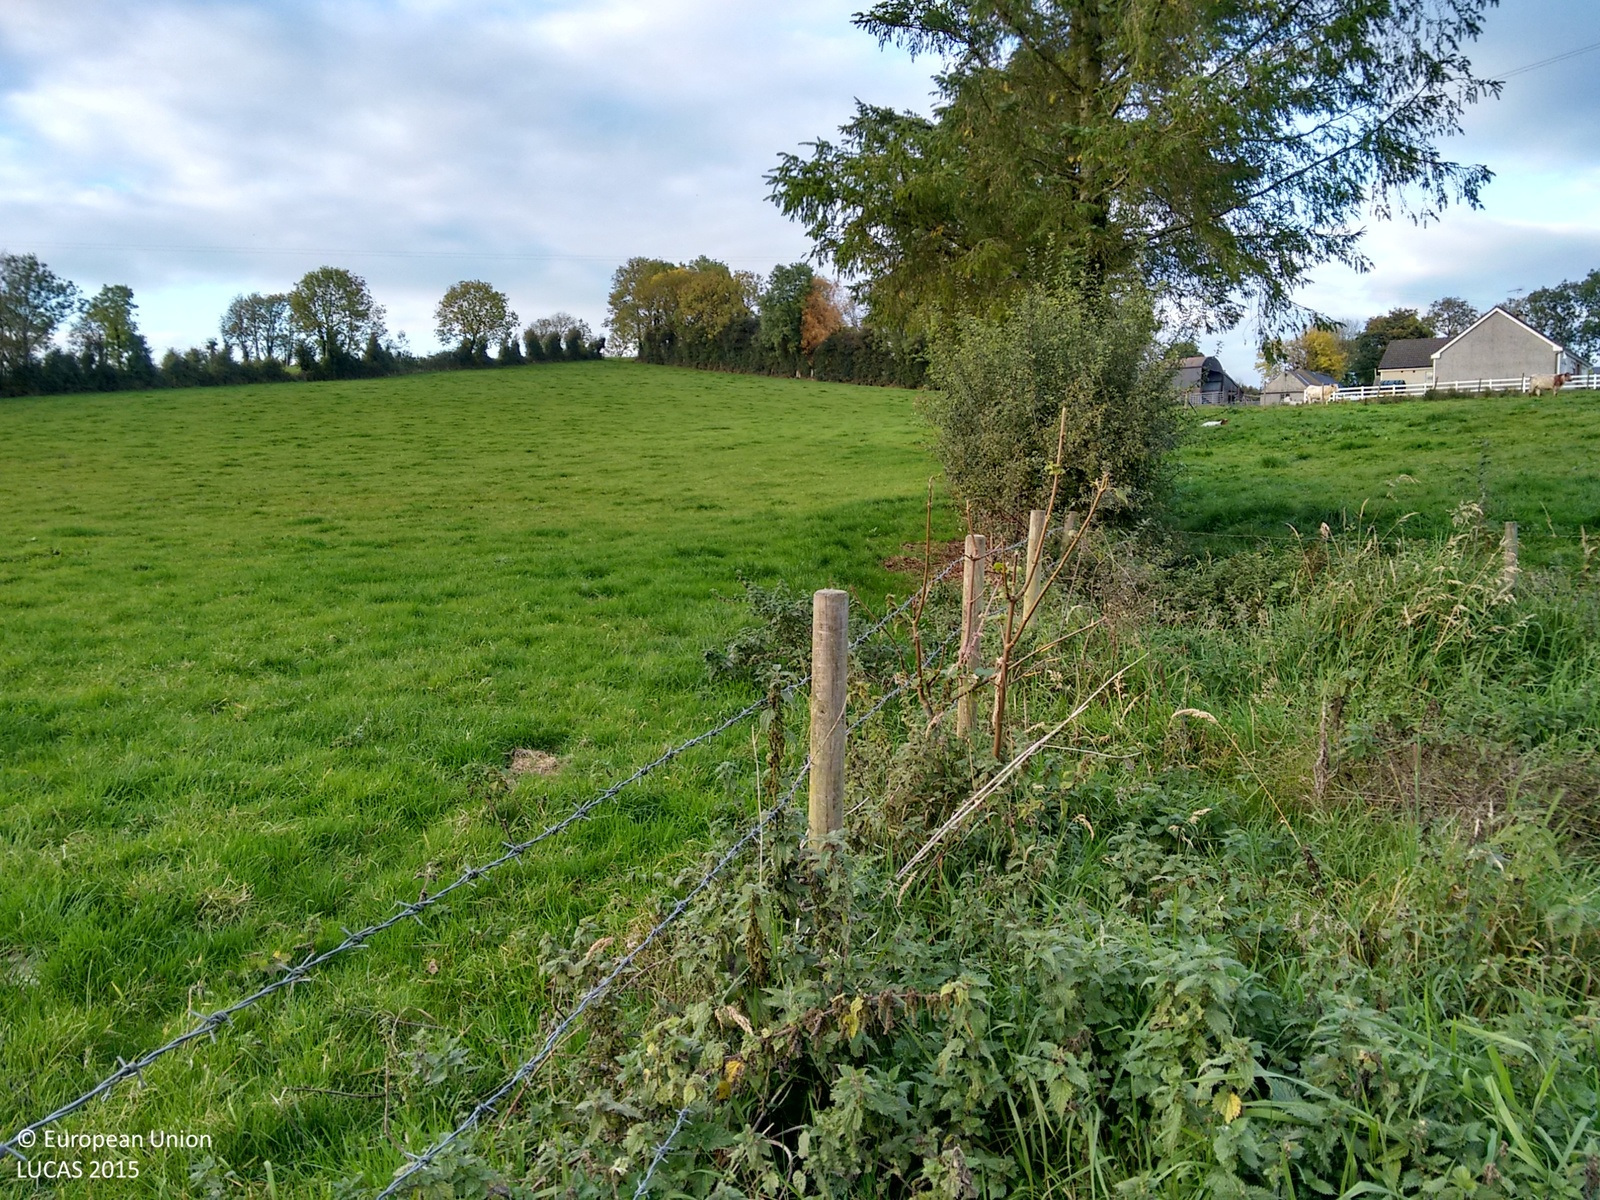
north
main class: Grassland
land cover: Grassland without tree/shrub cover
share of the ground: > 75 %
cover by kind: herbaceous plants 100 %
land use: Agriculture (excluding fallow land and kitchen gardens)
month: October
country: GB
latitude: 54.1444
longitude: -7.3432
